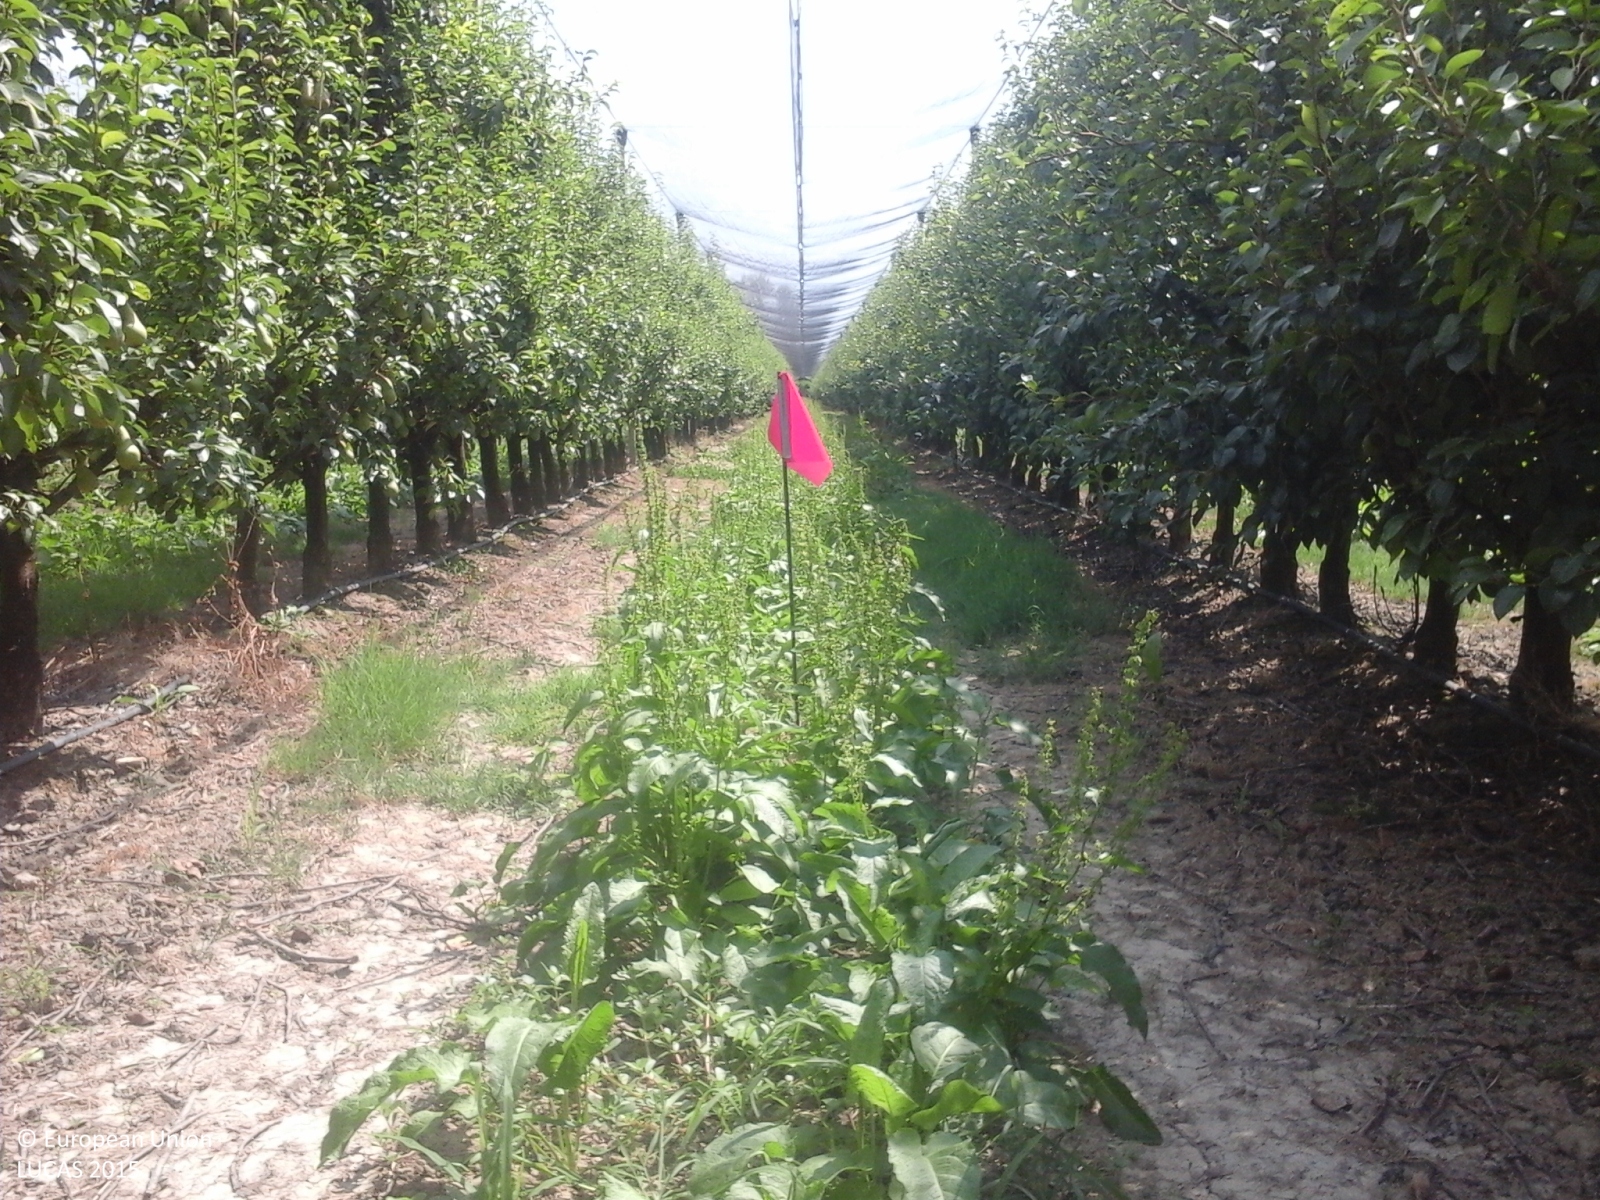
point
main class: Cropland
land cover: Pear fruit
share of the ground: > 75 %
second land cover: Grassland without tree/shrub cover
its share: > 75 %
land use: Agriculture (excluding fallow land and kitchen gardens)
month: June
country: IT
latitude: 44.8858
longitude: 11.0993
